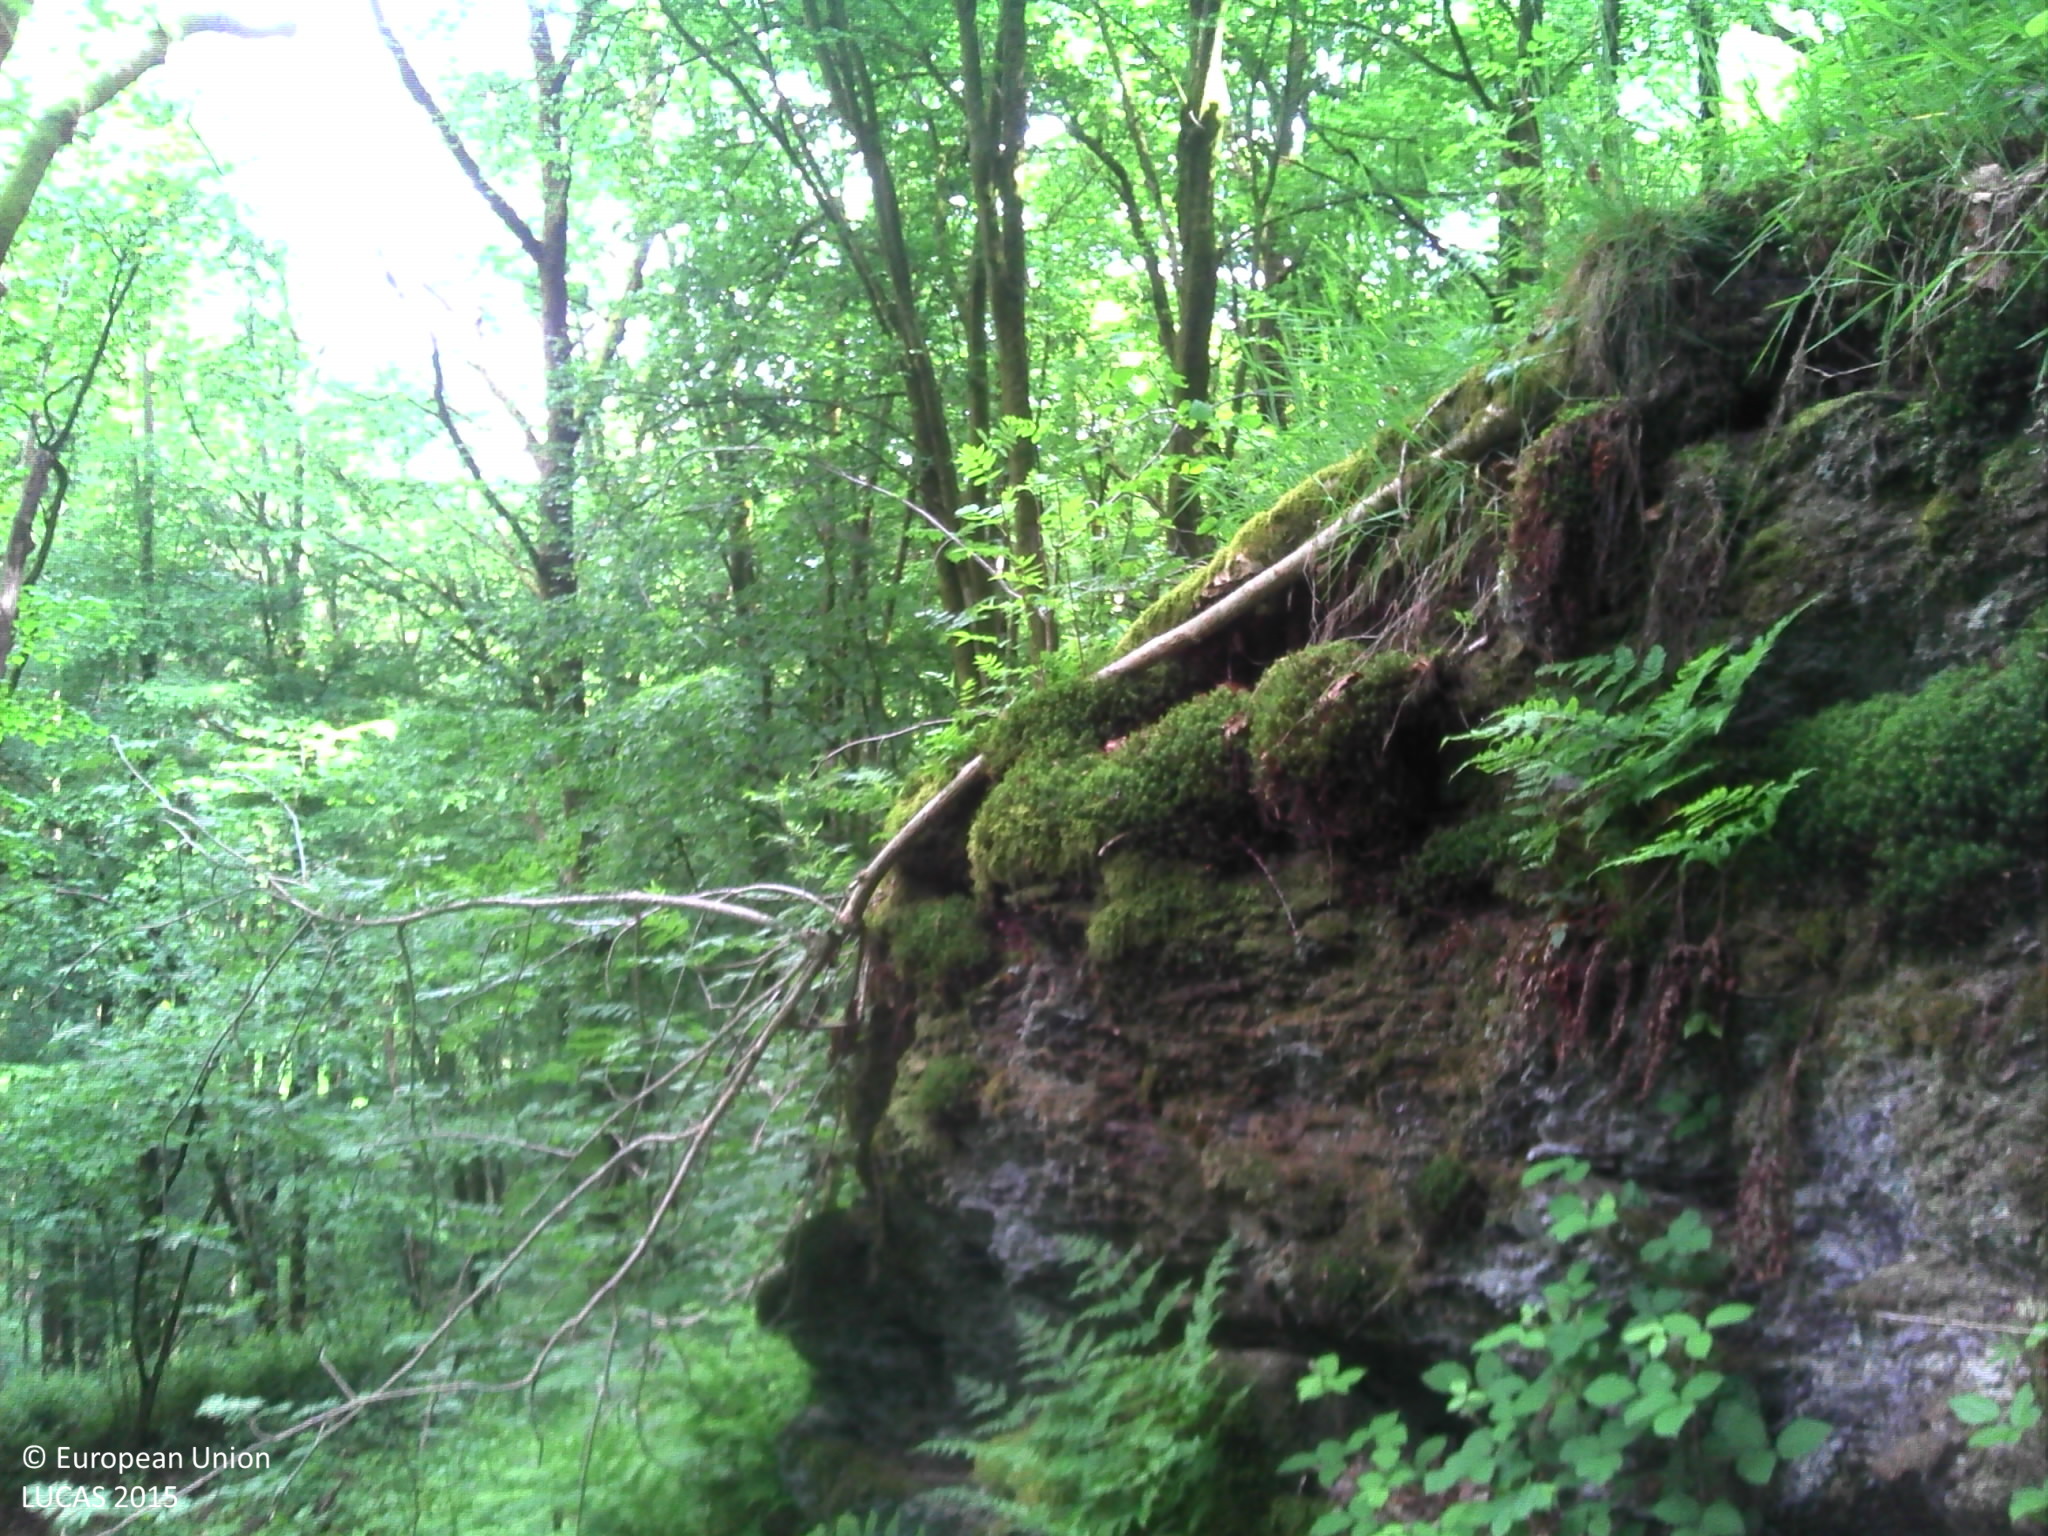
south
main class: Woodland
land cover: Broadleaved woodland
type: acidophilous oak and oak-birch forest
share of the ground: > 75 %
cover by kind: broadleaved forest trees 95 %, herbaceous plants 5 %
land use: Forestry
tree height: > 5 m
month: June
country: BE
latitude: 49.8895
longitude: 4.8888
